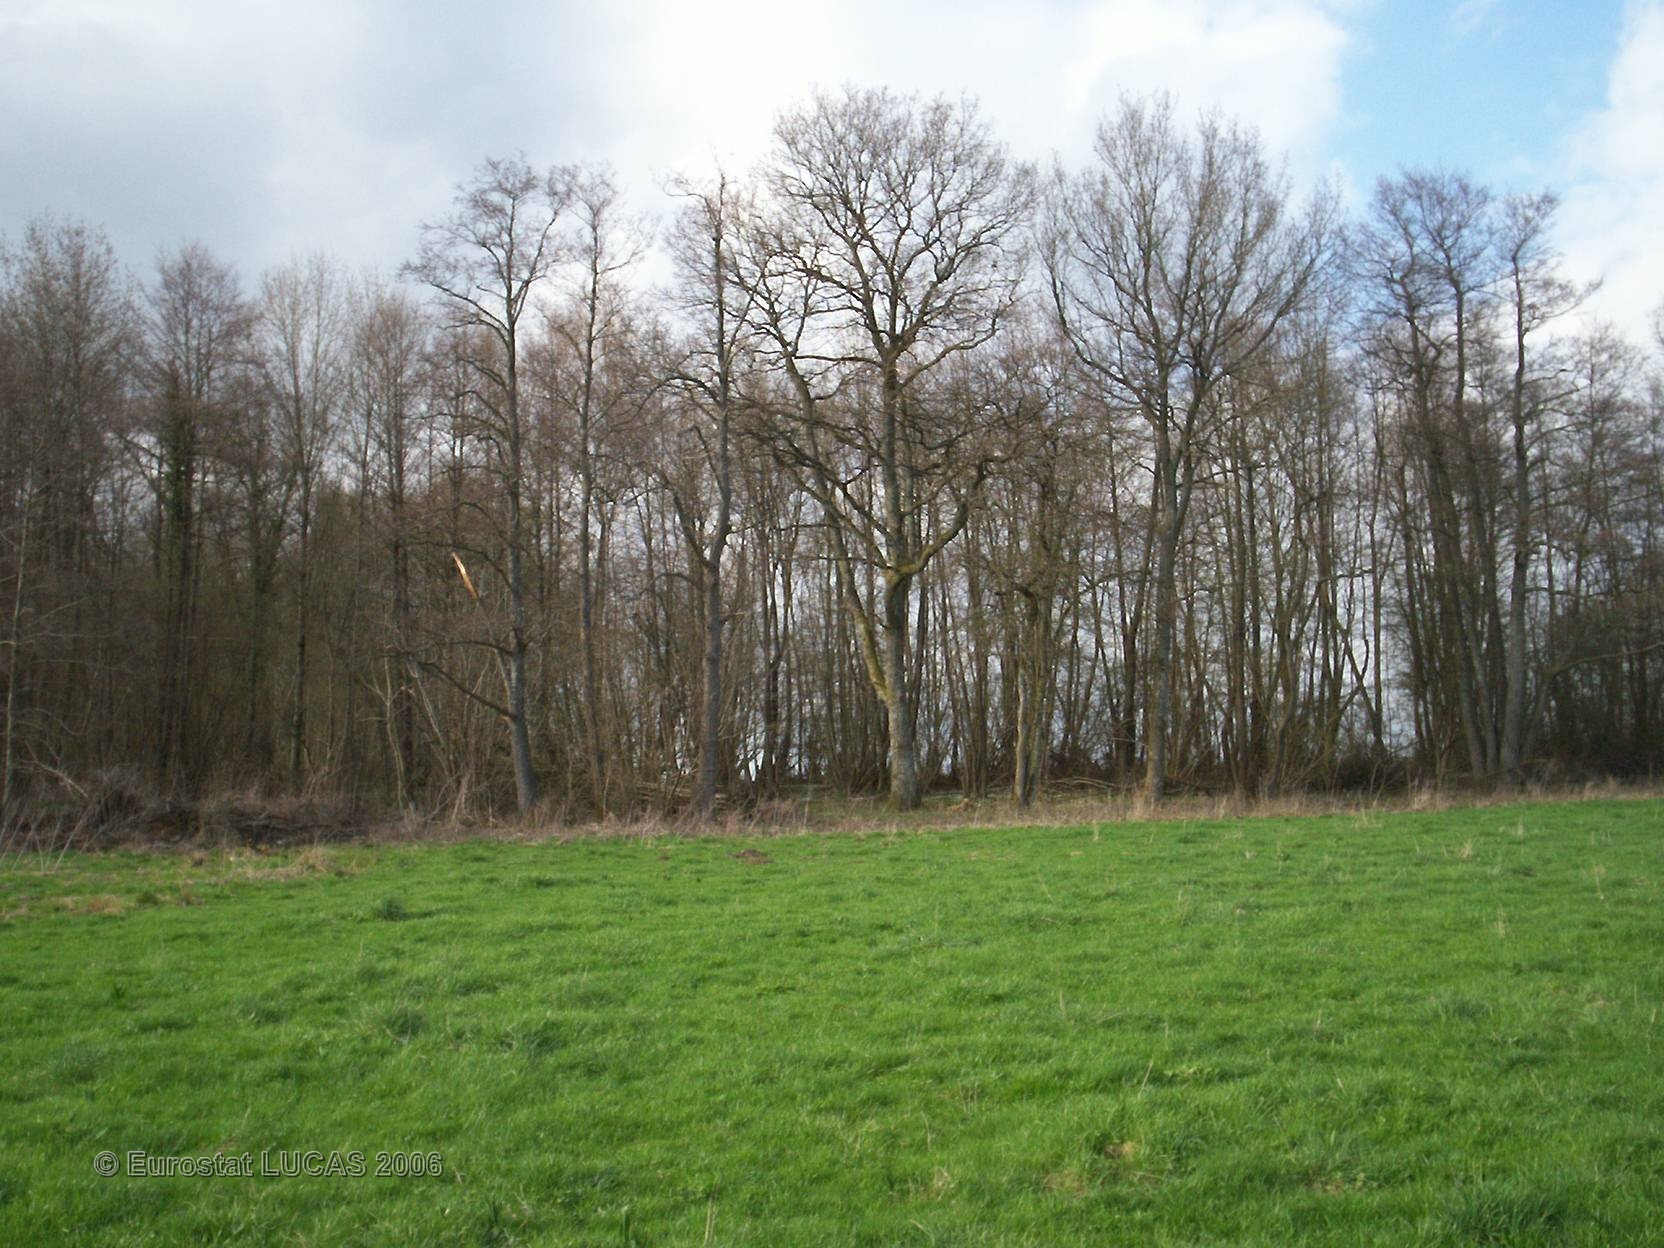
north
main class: Grassland
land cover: Grassland without tree/shrub cover
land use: Agriculture (excluding fallow land and kitchen gardens)
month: April
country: FR
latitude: 49.5177
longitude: 5.0387
